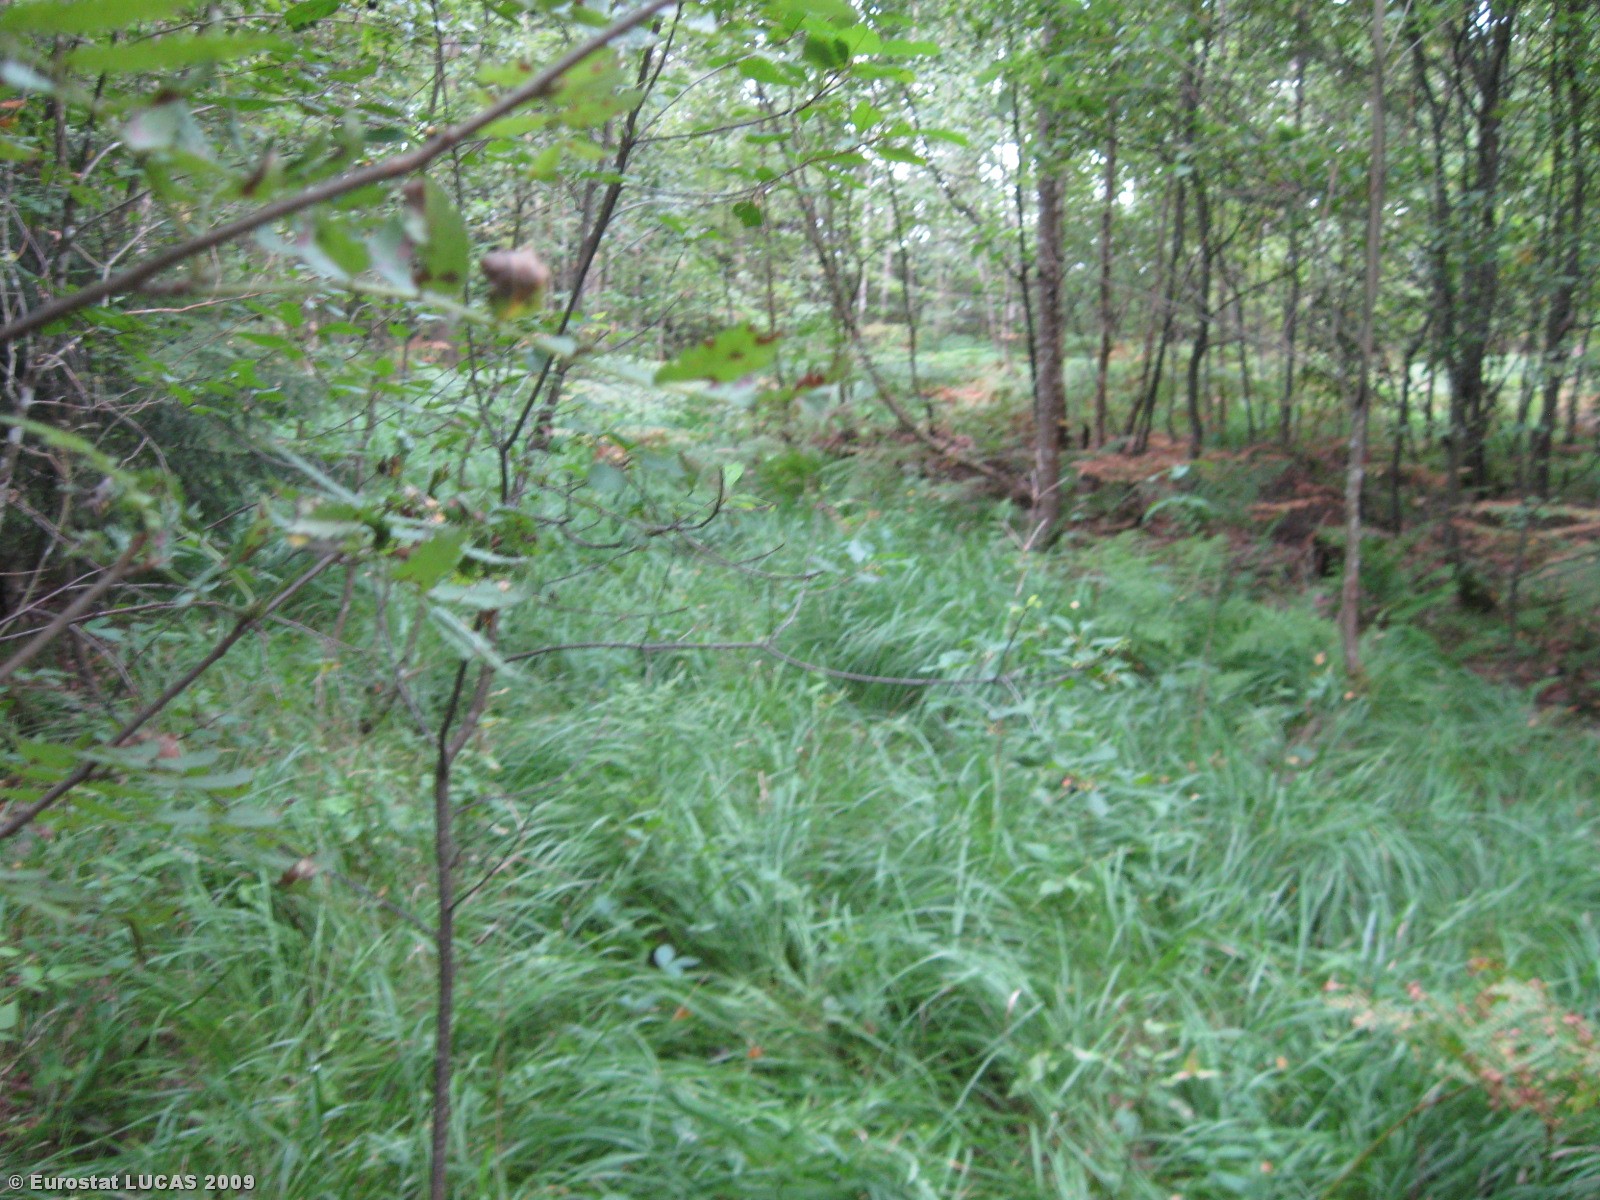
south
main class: Woodland
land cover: Mixed woodland
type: hemiboreal forest and nemoral coniferous forest and mixed broadleaved-coniferous forest
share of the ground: > 75 %
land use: Forestry
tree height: > 5 m
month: August
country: LT
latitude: 55.0915
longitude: 22.5830
